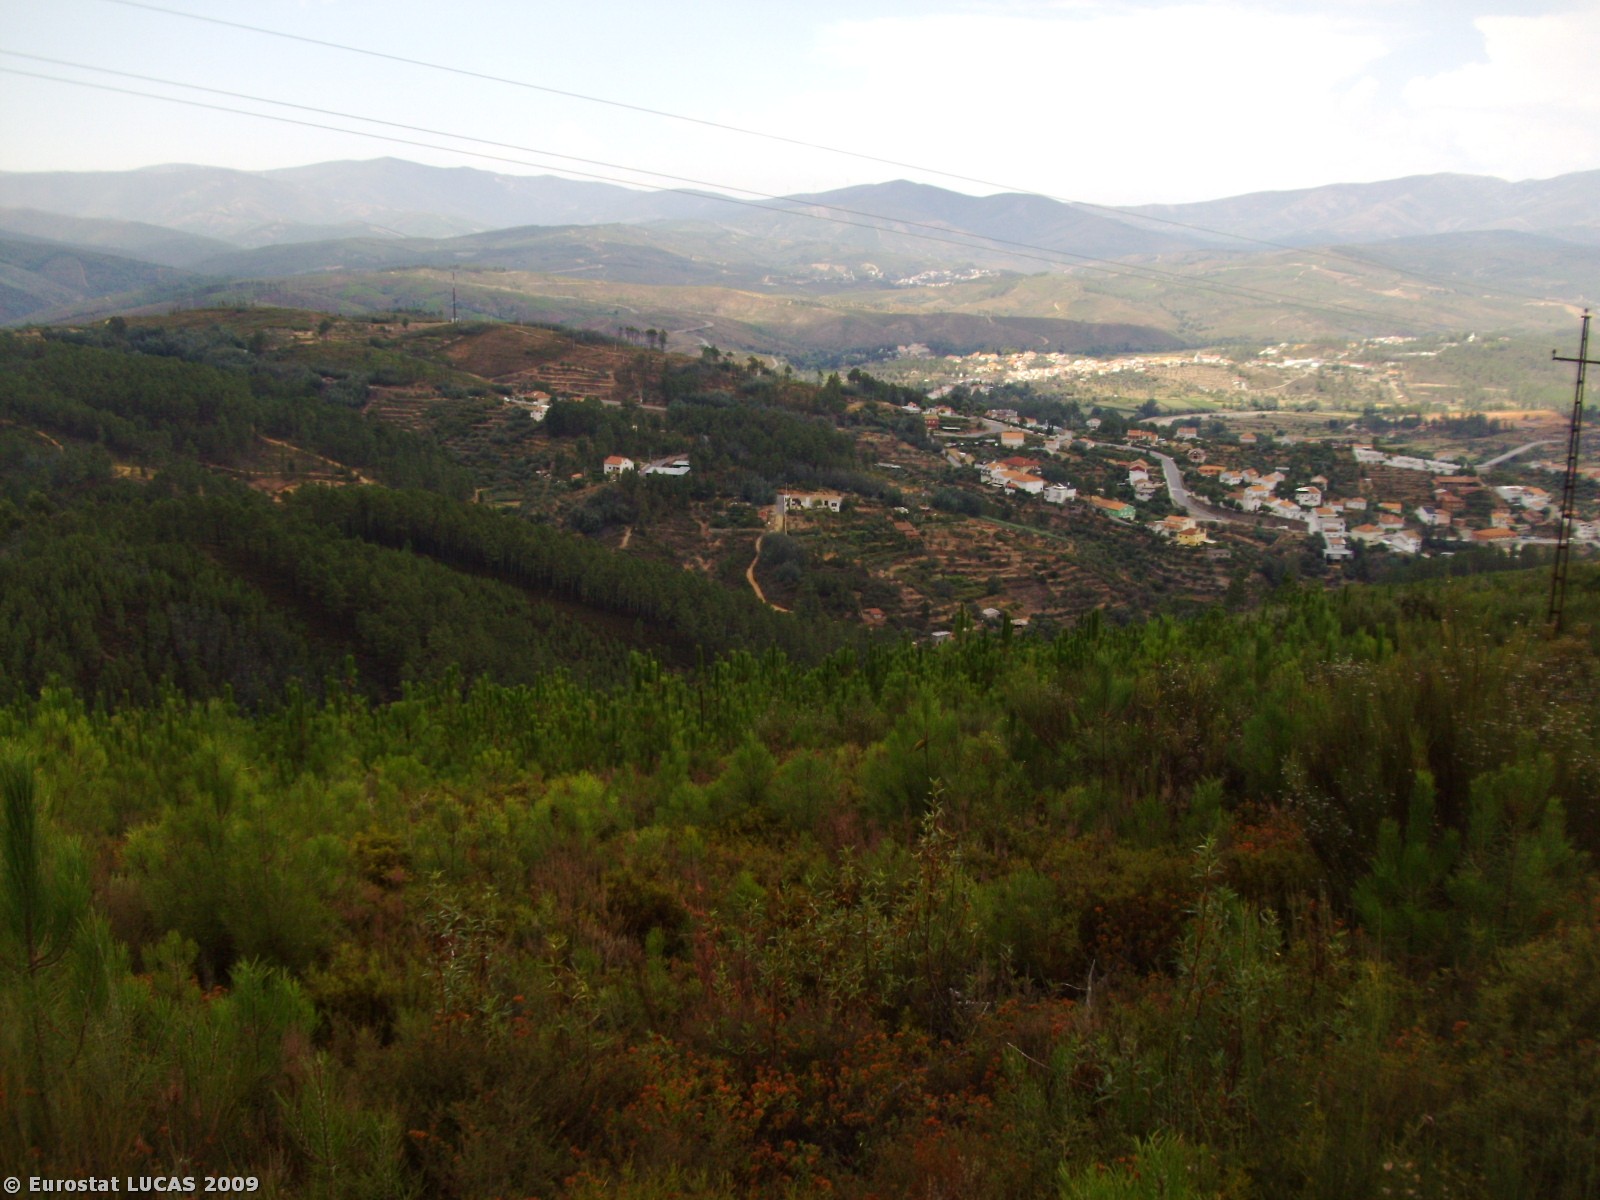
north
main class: Woodland
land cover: Coniferous woodland
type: coniferous forest of the mediterranean region
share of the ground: > 75 %
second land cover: Shrubland with sparse tree cover
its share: 10 - 25 %
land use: Forestry
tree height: > 5 m
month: August
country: PT
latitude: 40.1252
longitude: -7.6758
